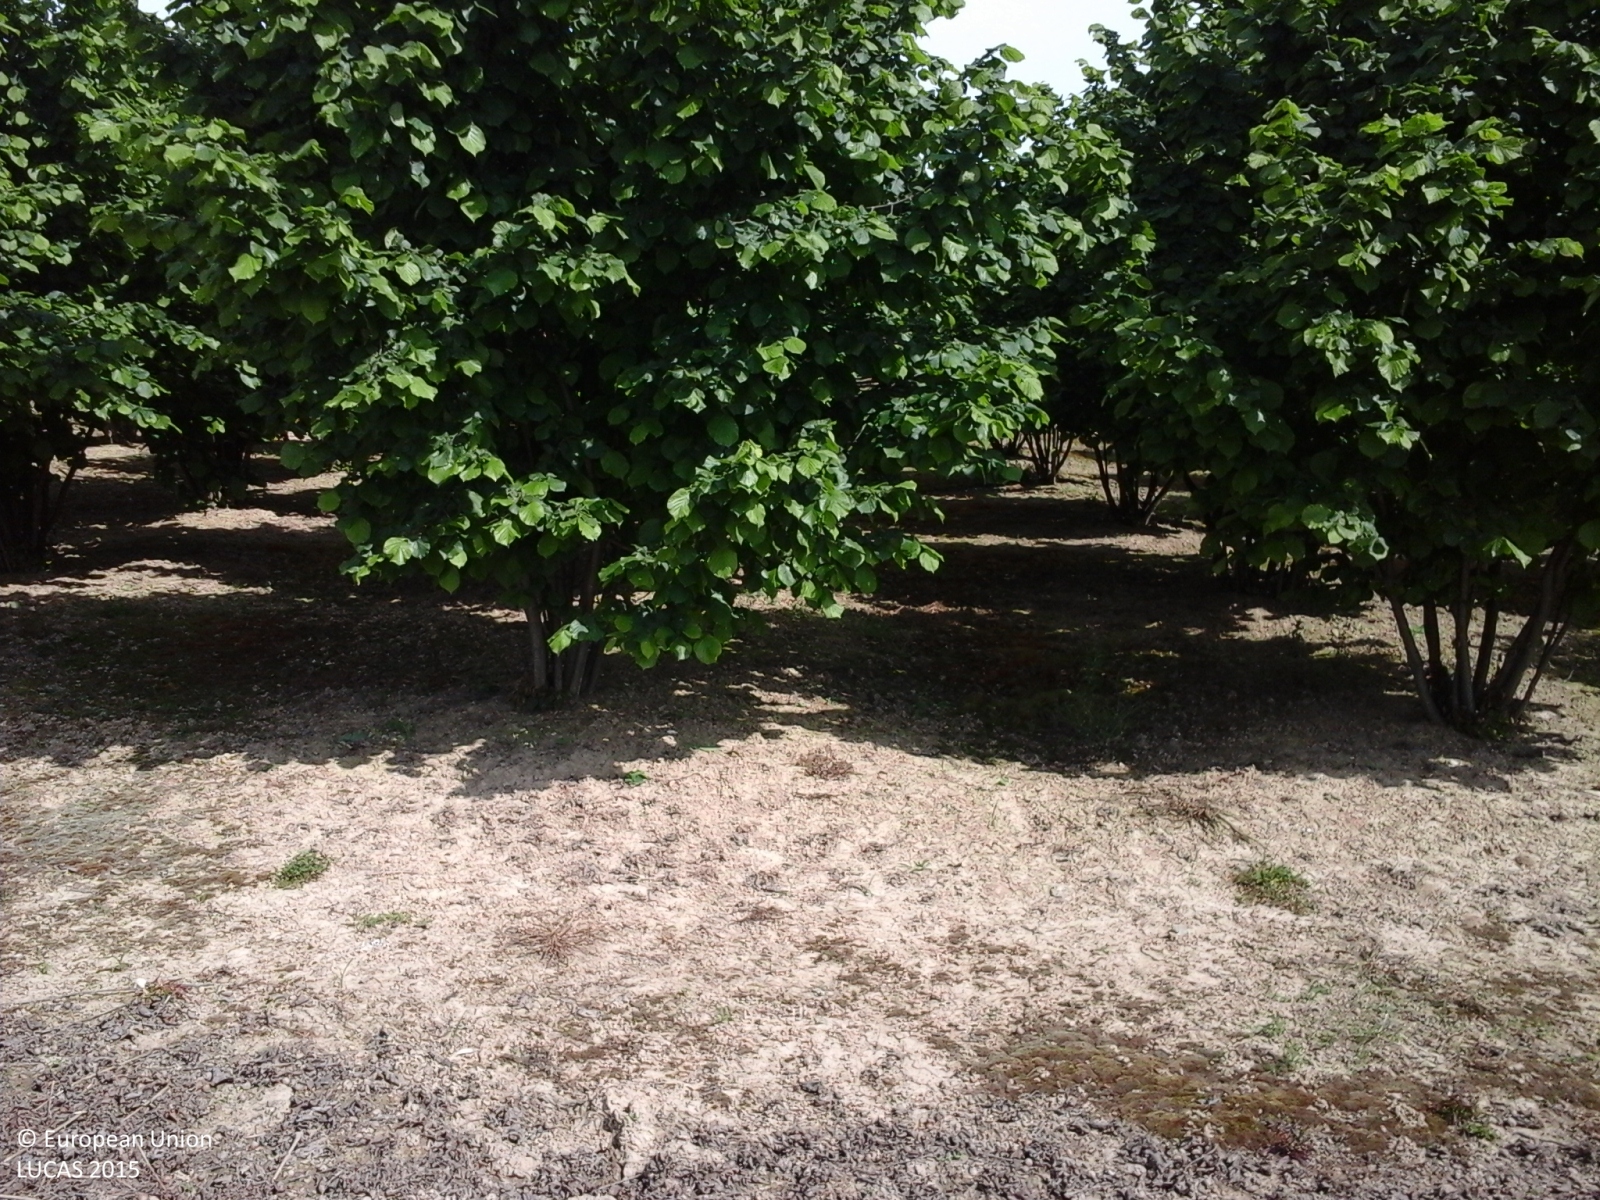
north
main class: Cropland
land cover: Common wheat
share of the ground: > 75 %
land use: Agriculture (excluding fallow land and kitchen gardens)
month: May
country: IT
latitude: 44.5072
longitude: 7.7782
